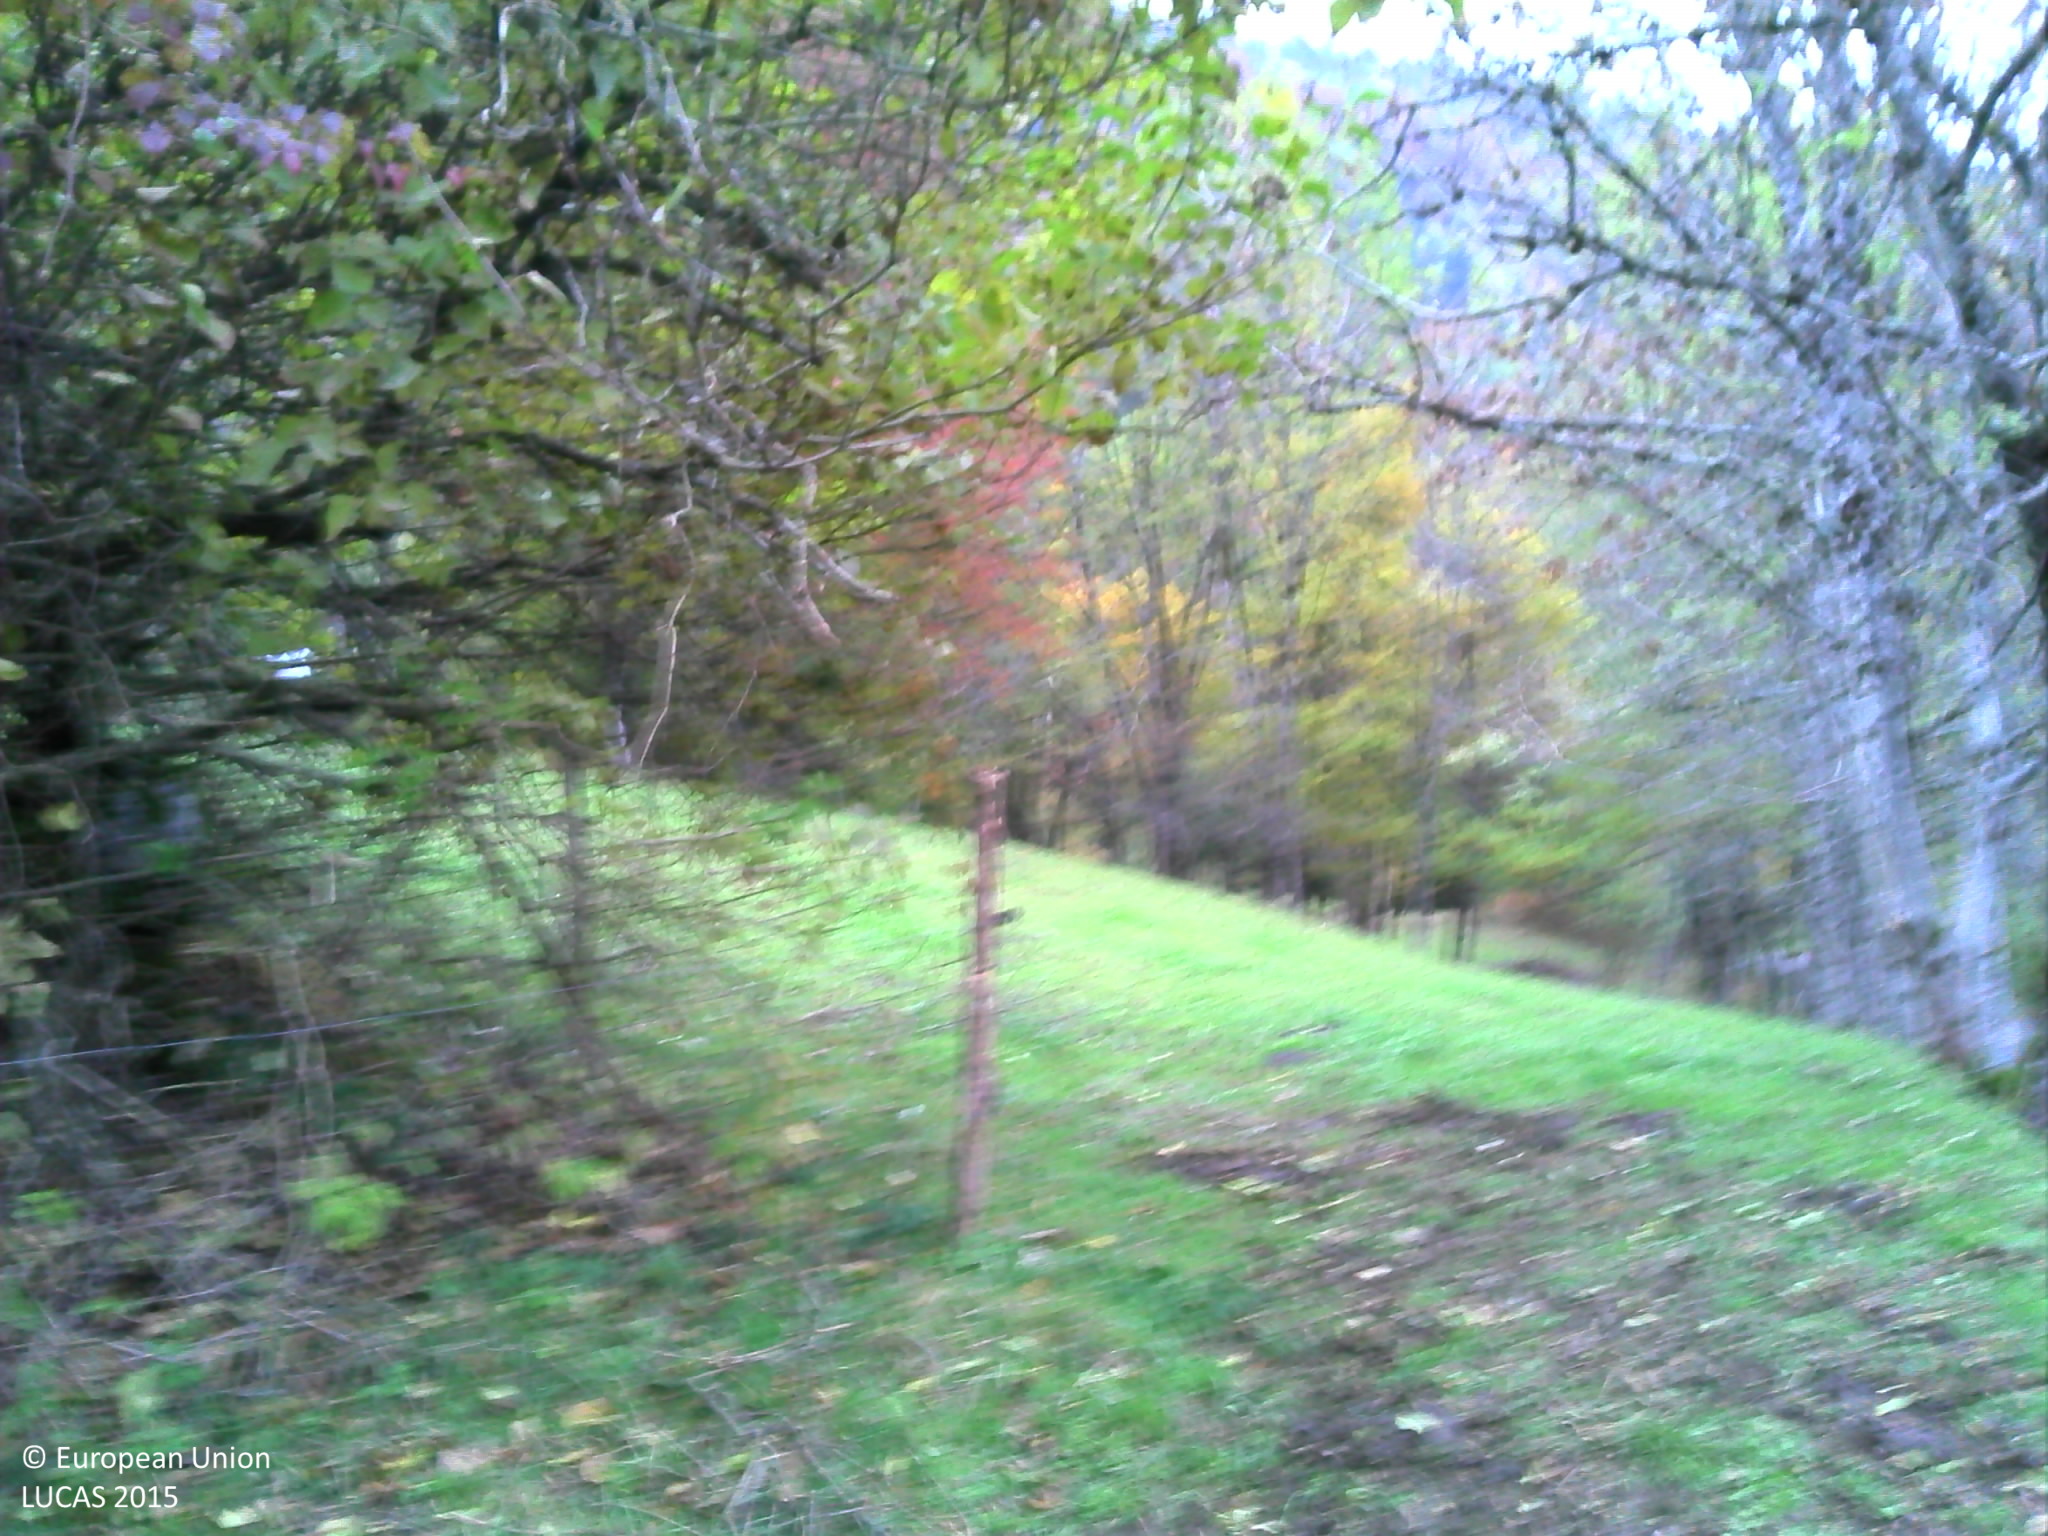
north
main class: Woodland
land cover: Broadleaved woodland
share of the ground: 50 - 75 %
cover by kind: herbaceous plants 70 %, broadleaved forest trees 30 %
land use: Agriculture (excluding fallow land and kitchen gardens)
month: October
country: FR
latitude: 45.5110
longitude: 6.2798
